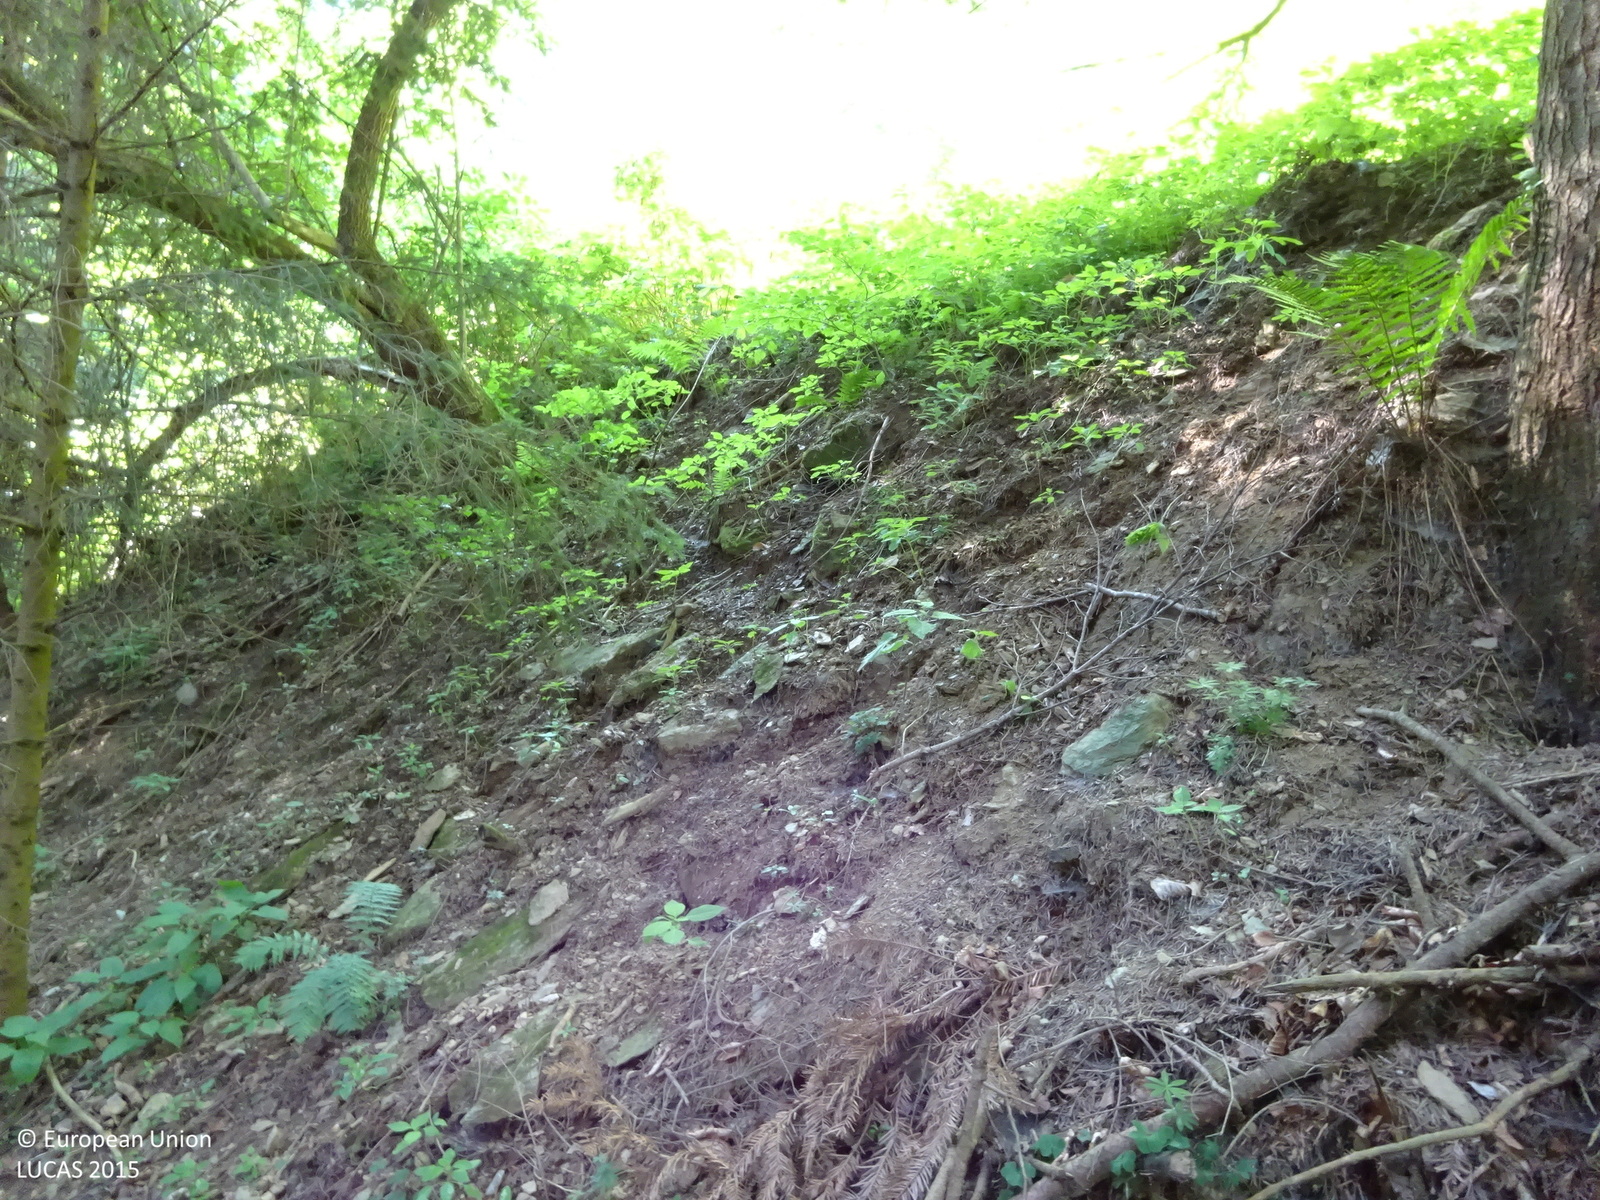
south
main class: Woodland
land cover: Spruce dominated coniferous woodland
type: alpine coniferous forest
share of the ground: > 75 %
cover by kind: coniferous forest trees 85 %, broadleaved forest trees 5 %, herbaceous plants 5 %, unconsolidated bare surface 5 %
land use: Forestry
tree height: > 5 m
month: July
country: AT
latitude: 47.2139
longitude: 15.2682
